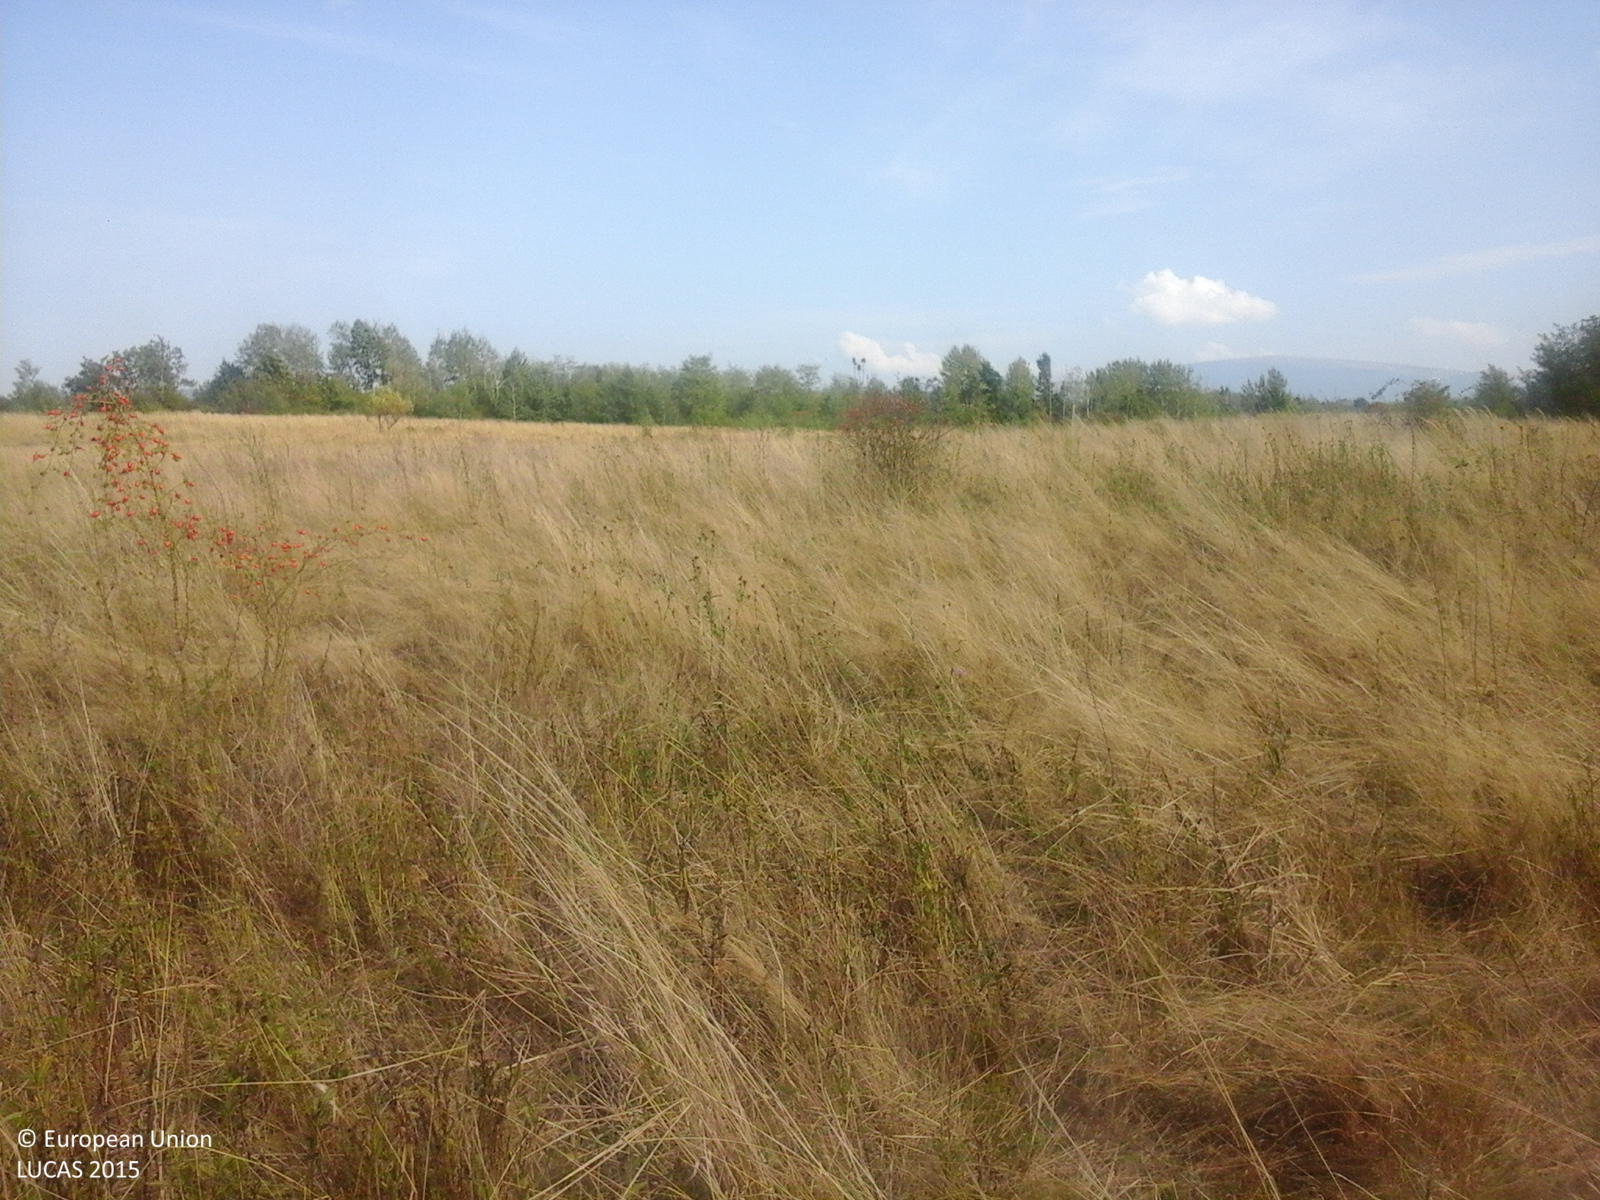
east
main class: Grassland
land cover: Grassland without tree/shrub cover
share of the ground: > 75 %
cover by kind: herbaceous plants 100 %
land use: Agriculture (excluding fallow land and kitchen gardens)
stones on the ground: < 10 %
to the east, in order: Grassland without tree/shrub cover; Grassland with sparse tree/shrub cover; Grassland without tree/shrub cover
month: September
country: RO
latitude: 45.3697
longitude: 22.2603
